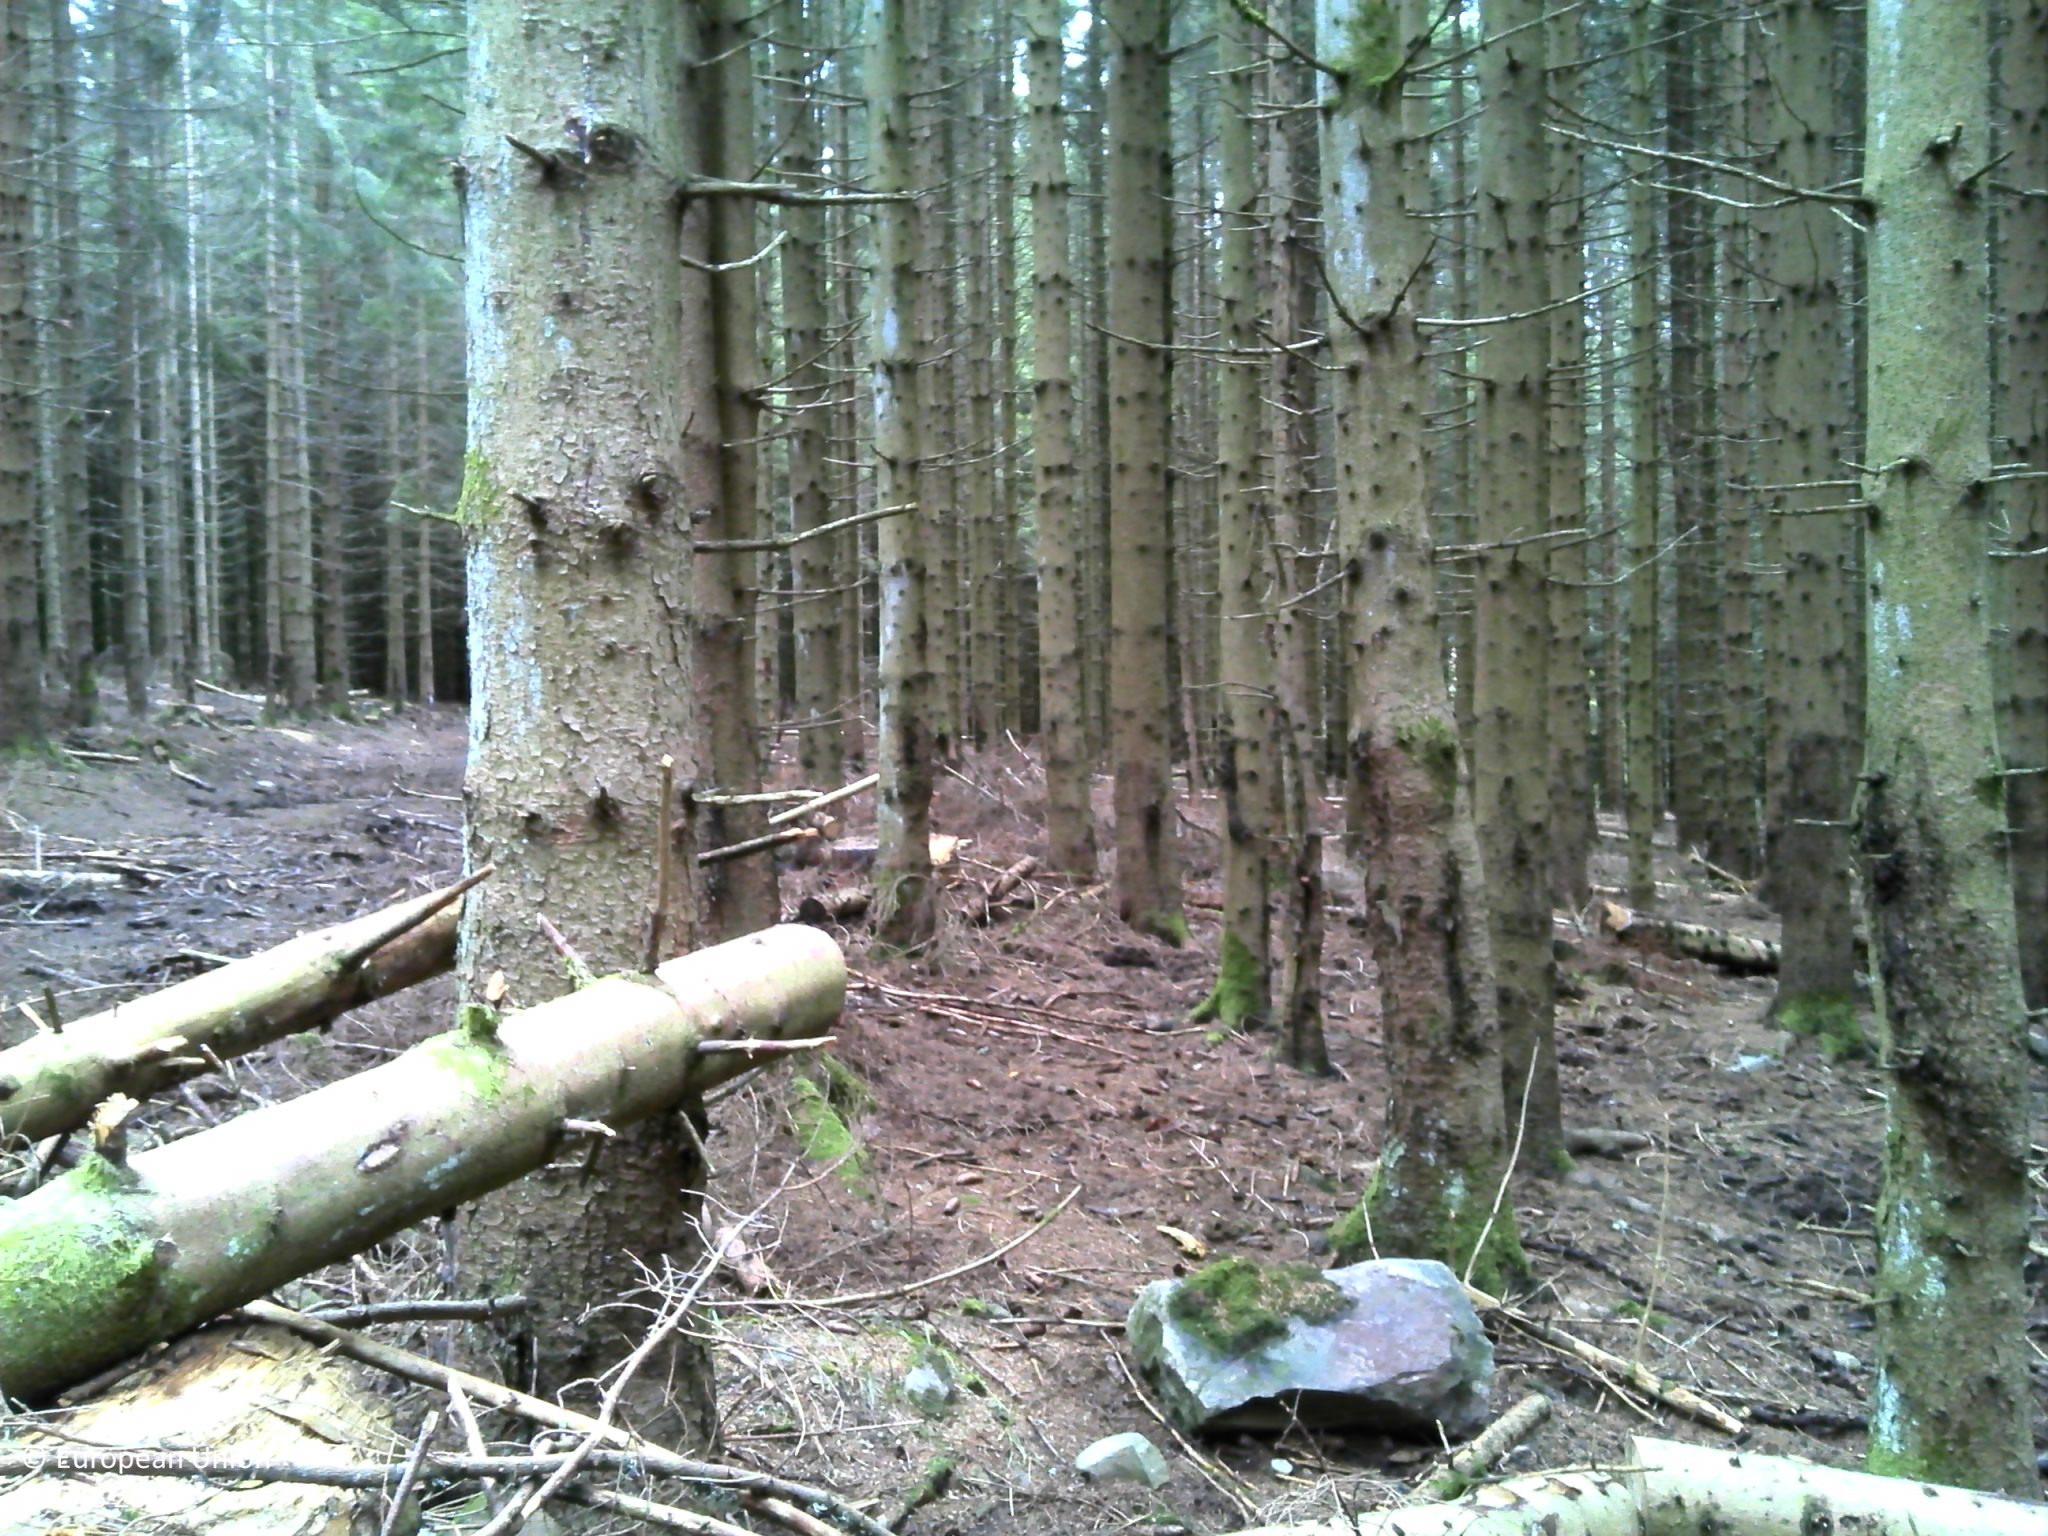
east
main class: Woodland
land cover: Spruce dominated coniferous woodland
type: exotic forest
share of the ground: > 75 %
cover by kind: coniferous forest trees 90 %, consolidated bare surface 10 %
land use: Forestry
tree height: > 5 m
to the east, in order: Spruce dominated coniferous woodland; Tracks; Spruce dominated coniferous woodland; Tracks; Spruce dominated mixed woodland; Tracks; Spruce dominated mixed woodland
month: September
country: FR
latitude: 48.4255
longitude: 7.3386
